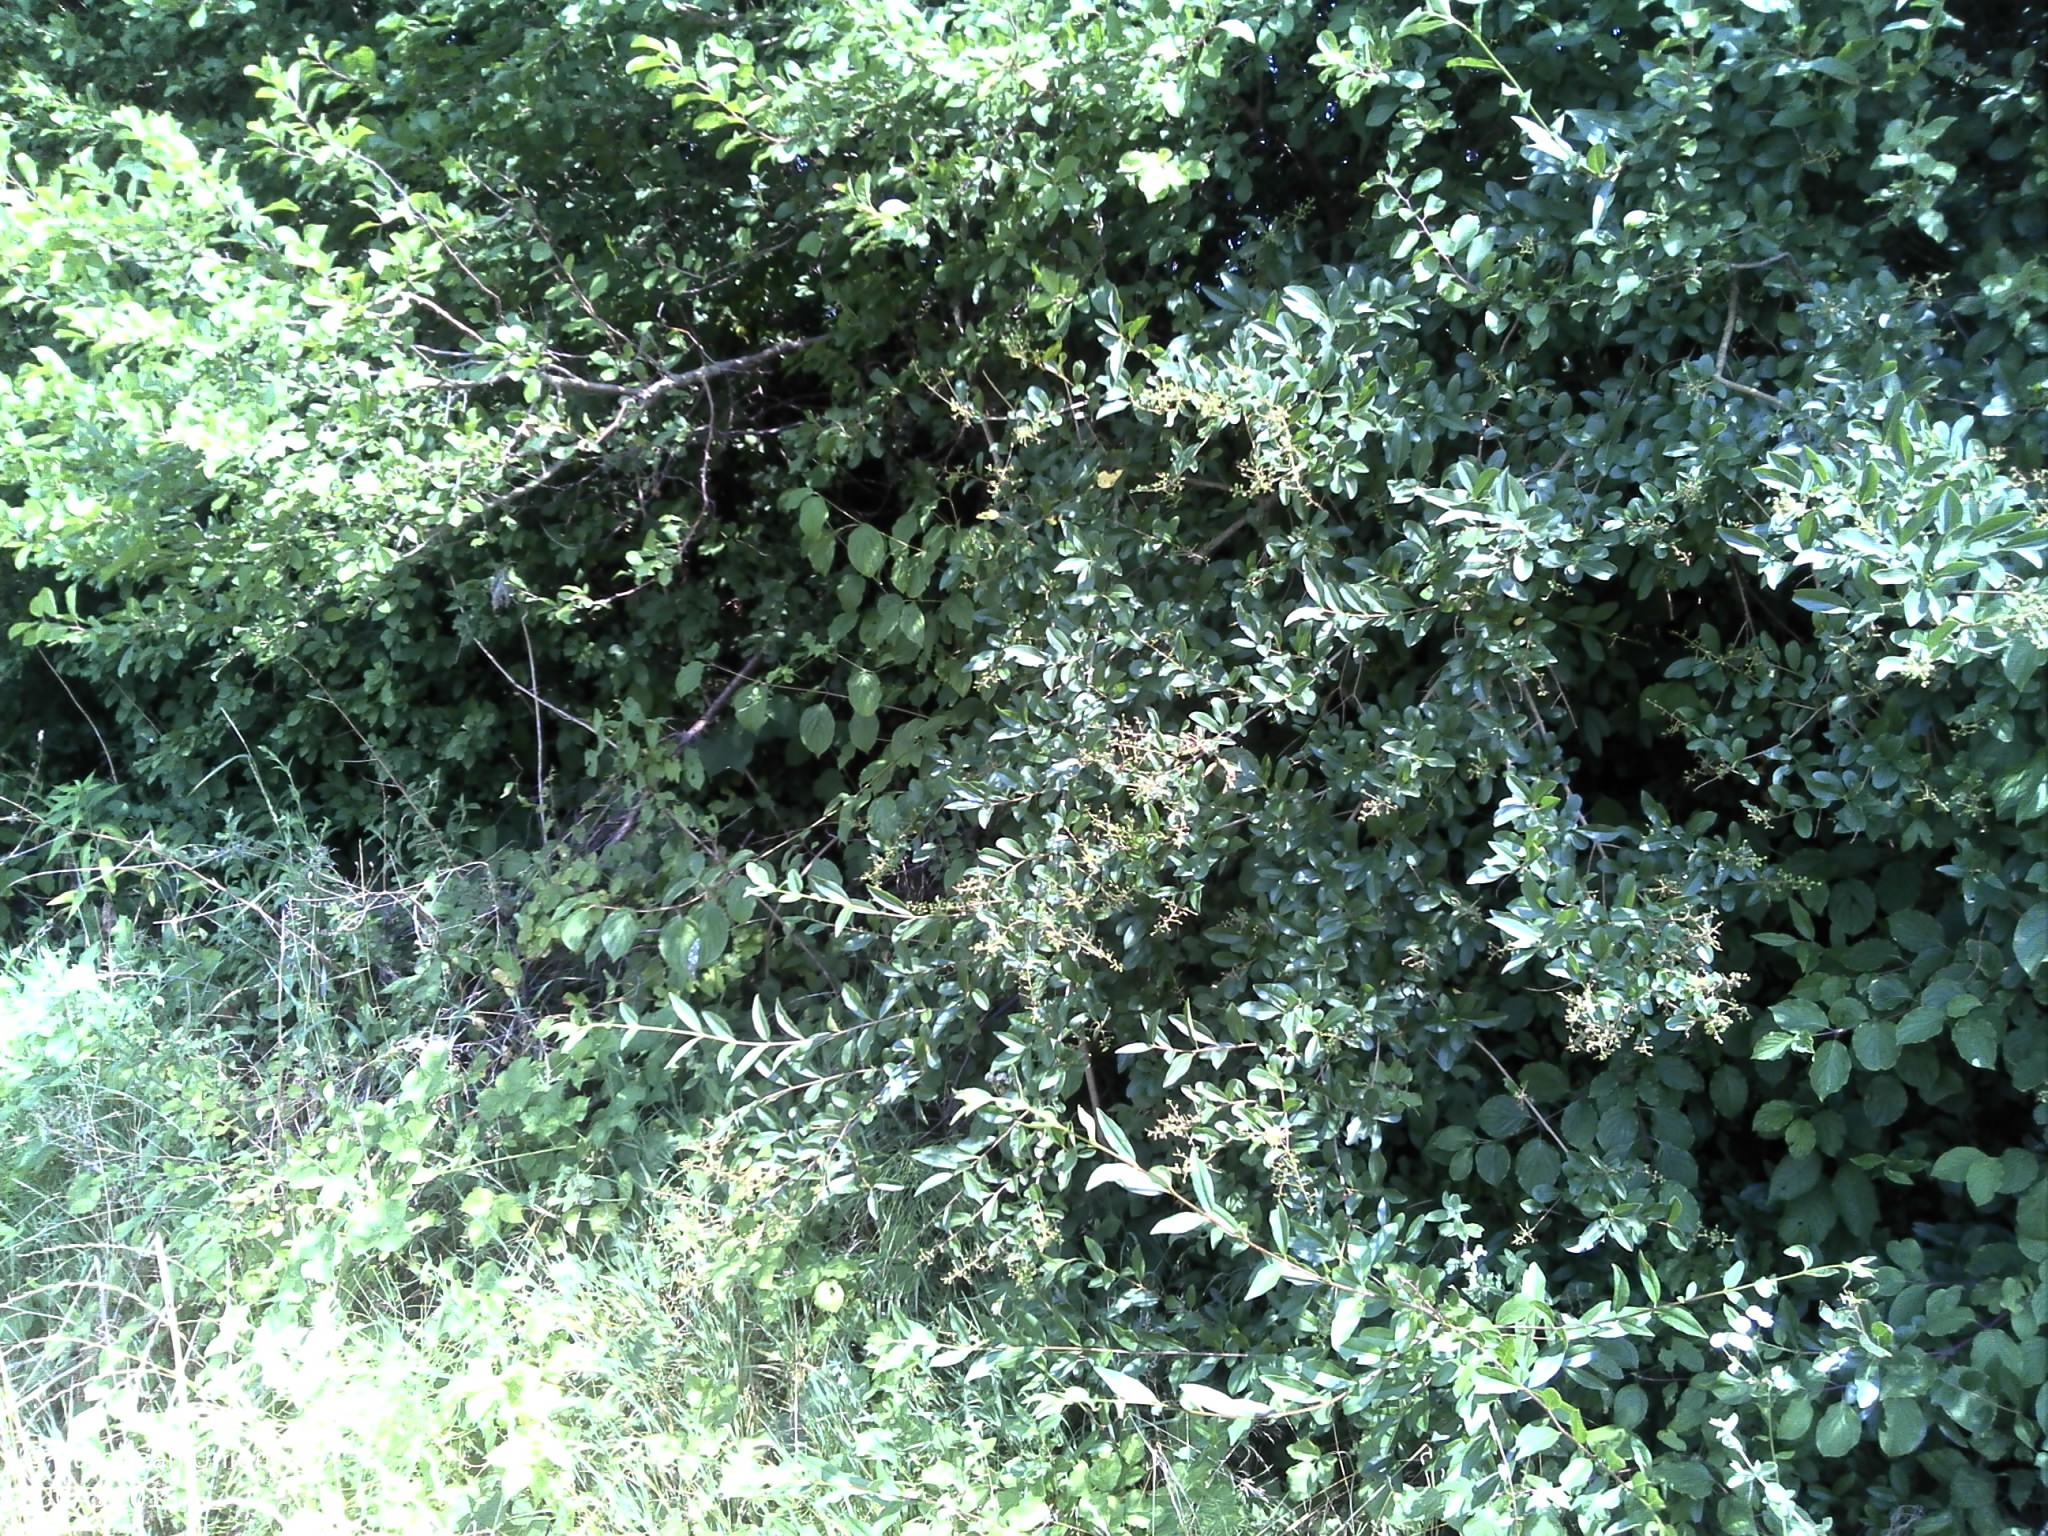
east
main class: Cropland
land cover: Oats
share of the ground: > 75 %
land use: Agriculture (excluding fallow land and kitchen gardens)
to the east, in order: Oats; Shrubland with sparse tree cover; Other bare soil; Shrubland without tree cover; Spontaneously vegetated surfaces; Maize; Shrubland with sparse tree cover; Temporary grasslands; Shrubland with sparse tree cover; Maize; Shrubland with sparse tree cover; Other bare soil; Grass margins; Shrubland without tree cover; Maize; Grass margins; Maize; Shrubland without tree cover; Broadleaved woodland
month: July
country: HR
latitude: 46.0111
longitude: 16.7551
